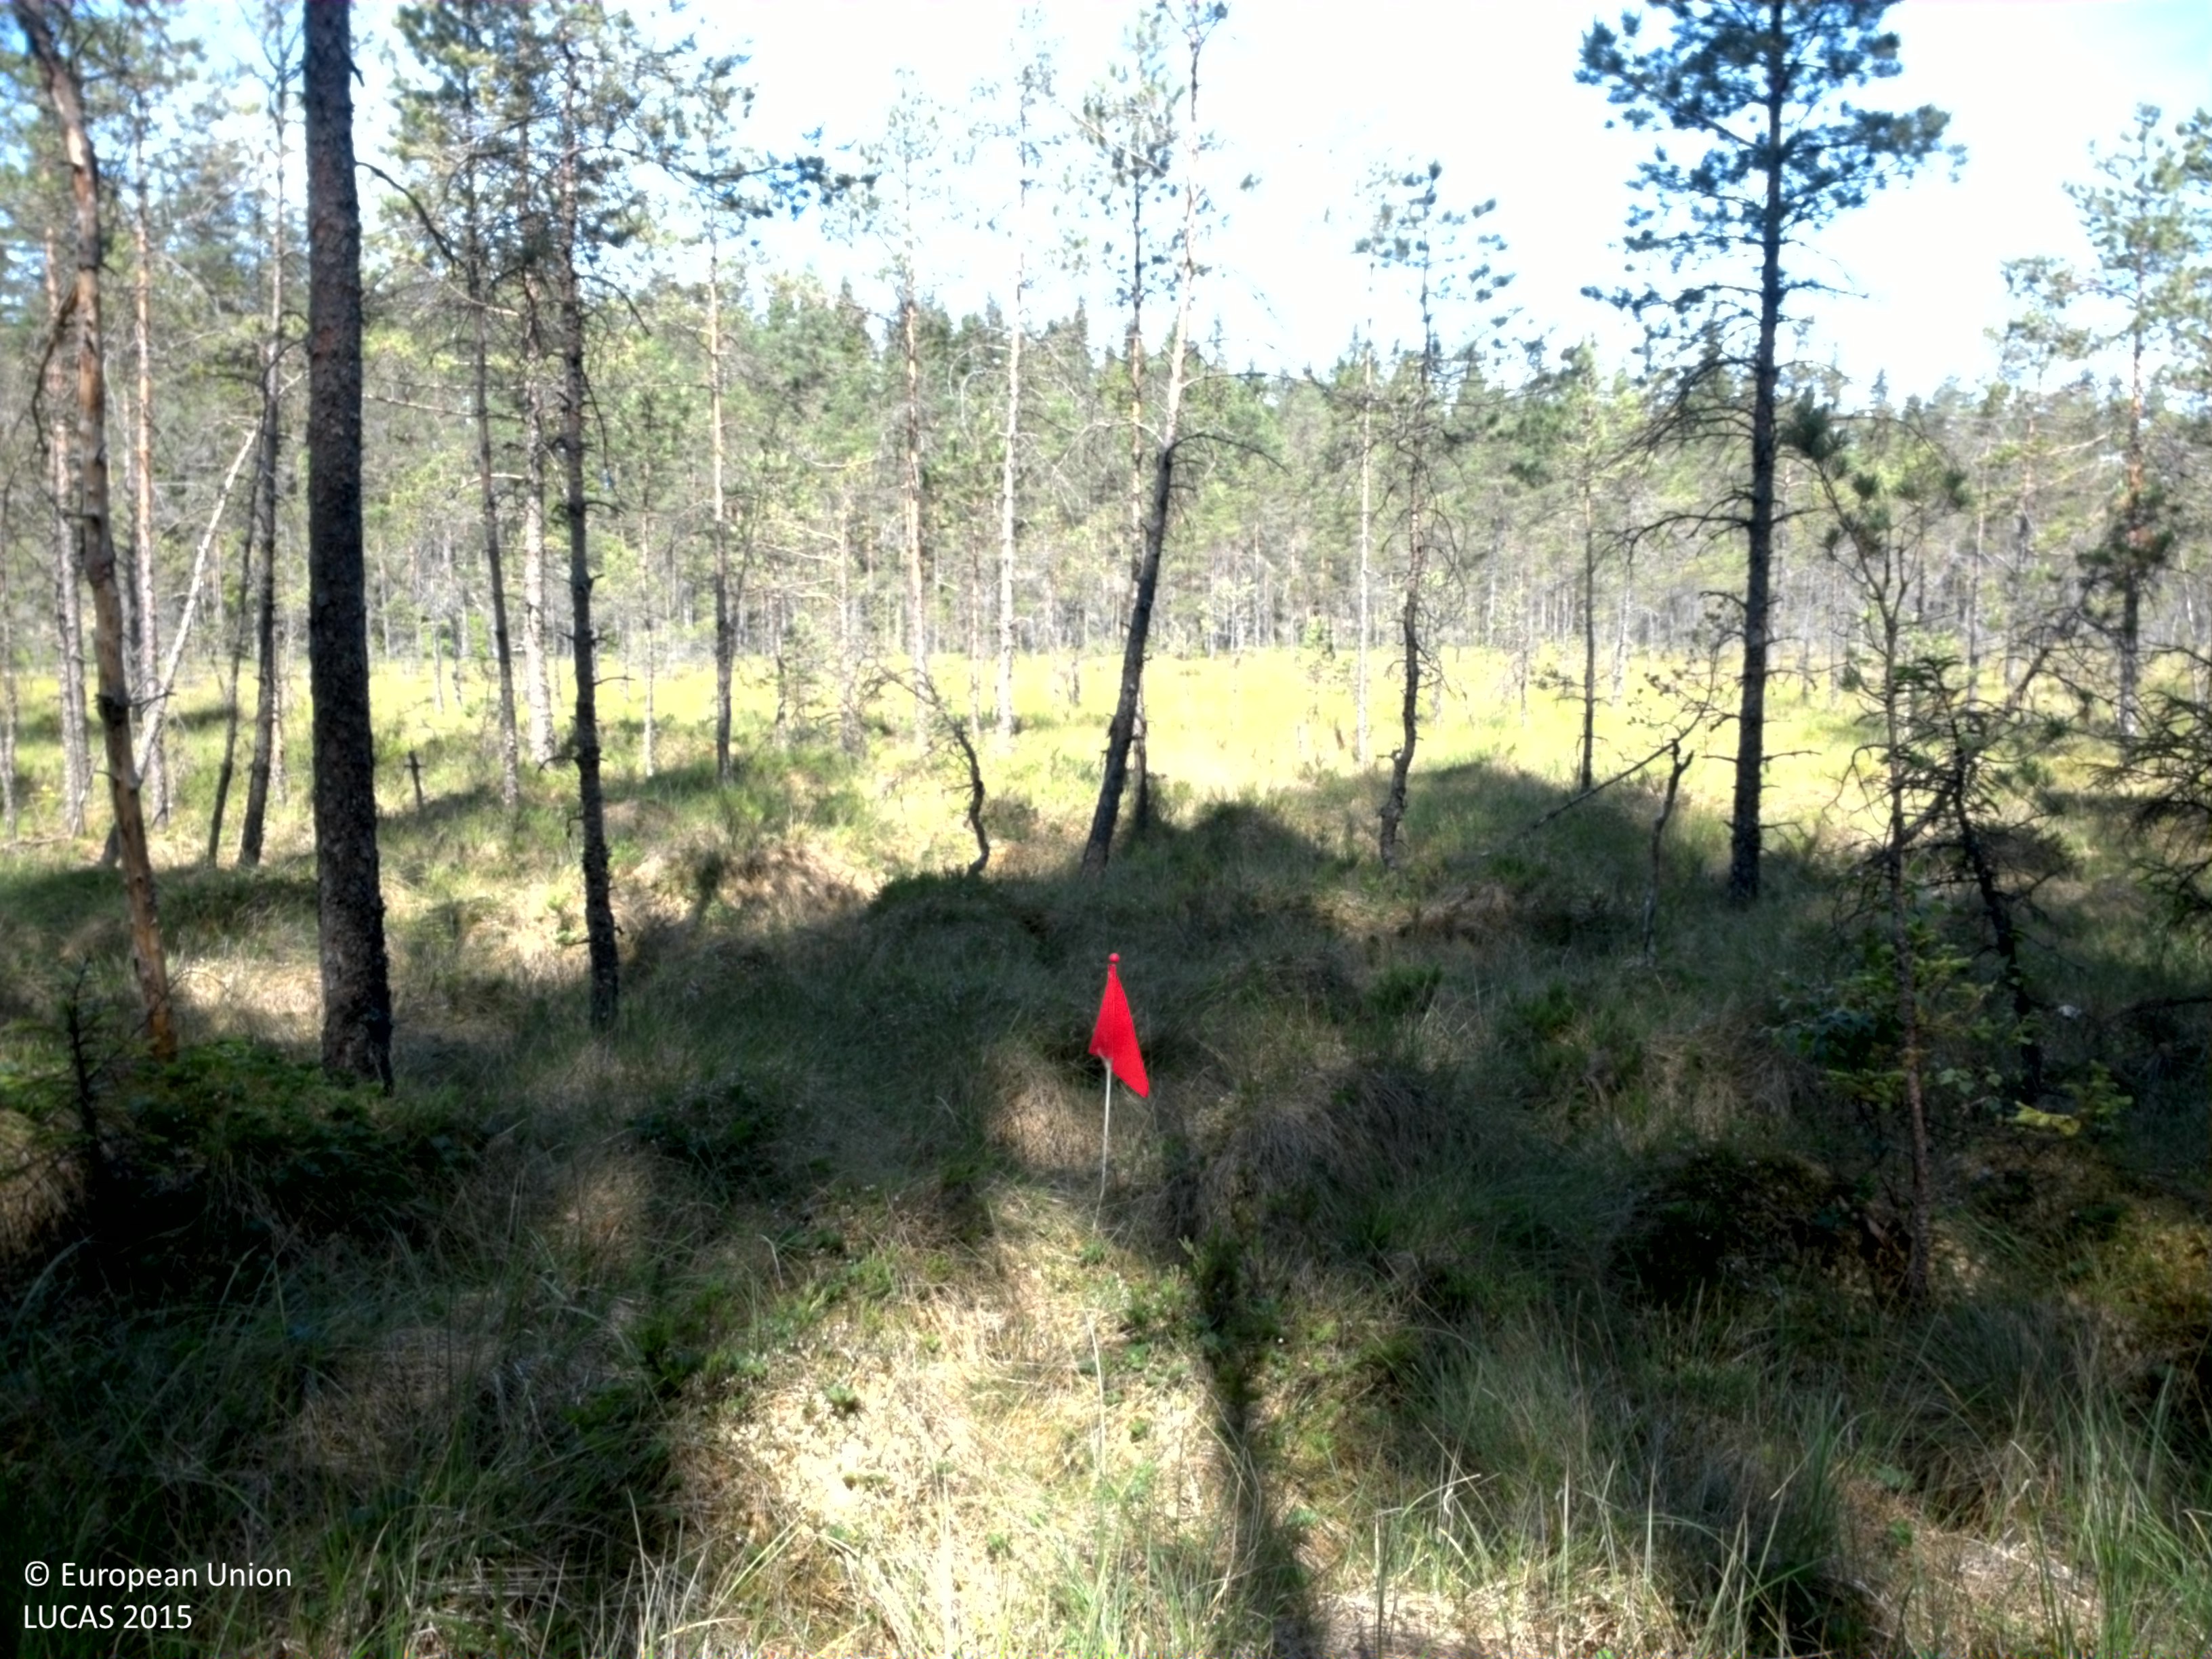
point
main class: Woodland
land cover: Pine dominated coniferous woodland
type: boreal forest
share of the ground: 10 - 25 %
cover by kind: lichens and mosses 45 %, coniferous forest trees 20 %, herbaceous plants 20 %, shrubs 10 %, broadleaved forest trees 5 %
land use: Forestry
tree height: > 5 m
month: July
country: SE
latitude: 57.6238
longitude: 13.8631
